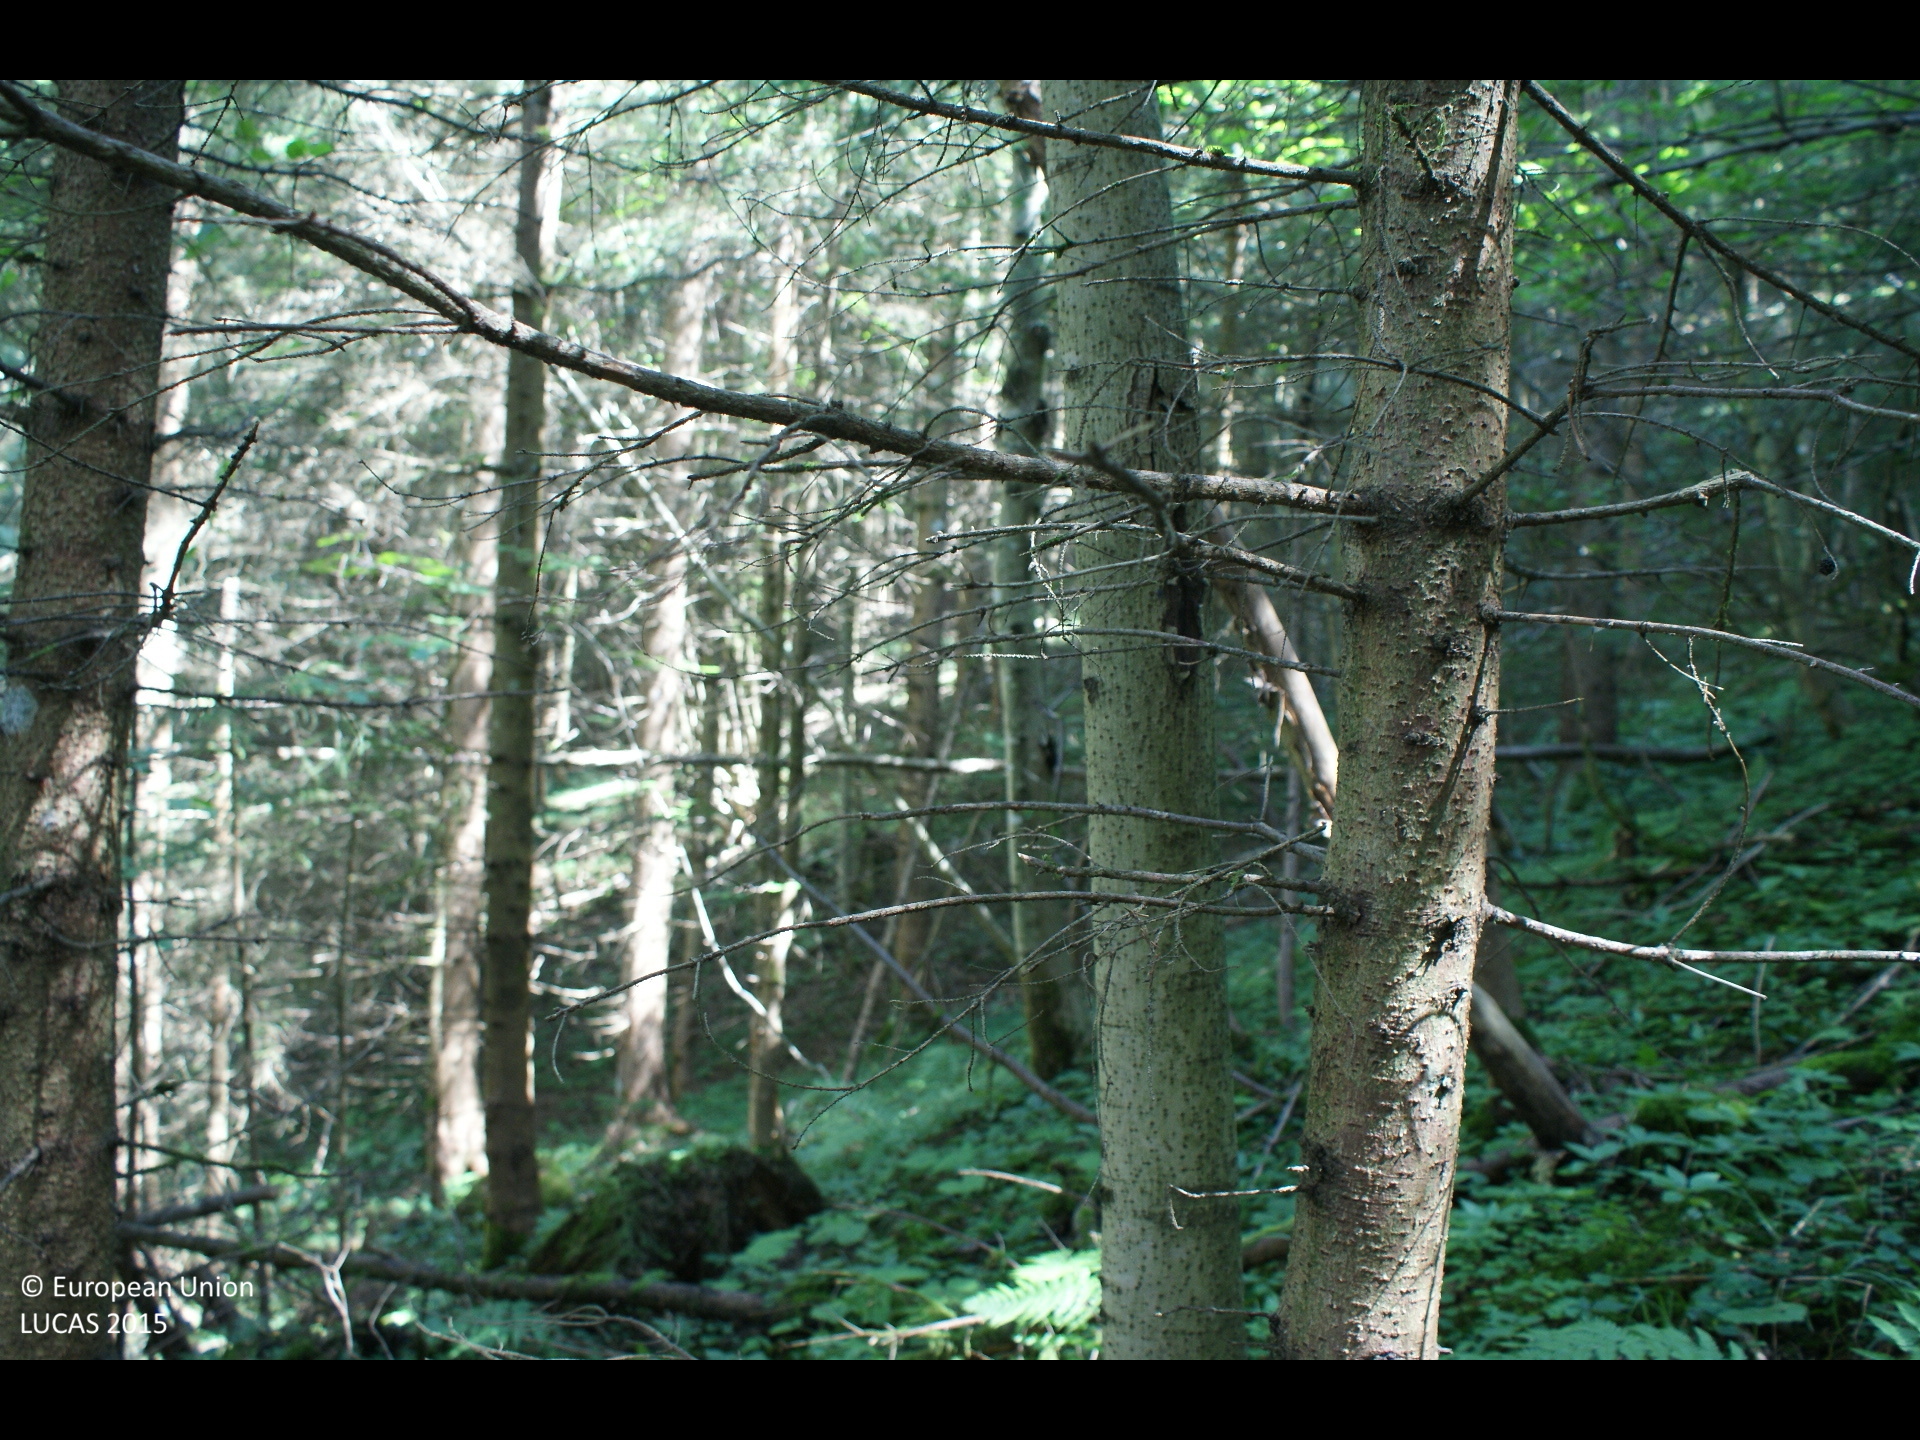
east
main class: Woodland
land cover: Spruce dominated mixed woodland
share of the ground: > 75 %
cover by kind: coniferous forest trees 65 %, broadleaved forest trees 25 %, herbaceous plants 5 %, lichens and mosses 5 %
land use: Forestry
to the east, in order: Spruce dominated mixed woodland; Spruce dominated coniferous woodland; Spontaneously vegetated surfaces; Spruce dominated coniferous woodland; Other mixed woodland; Tracks; Spruce dominated coniferous woodland; Tracks; Spruce dominated coniferous woodland
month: July
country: AT
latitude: 47.7937
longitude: 14.8194
